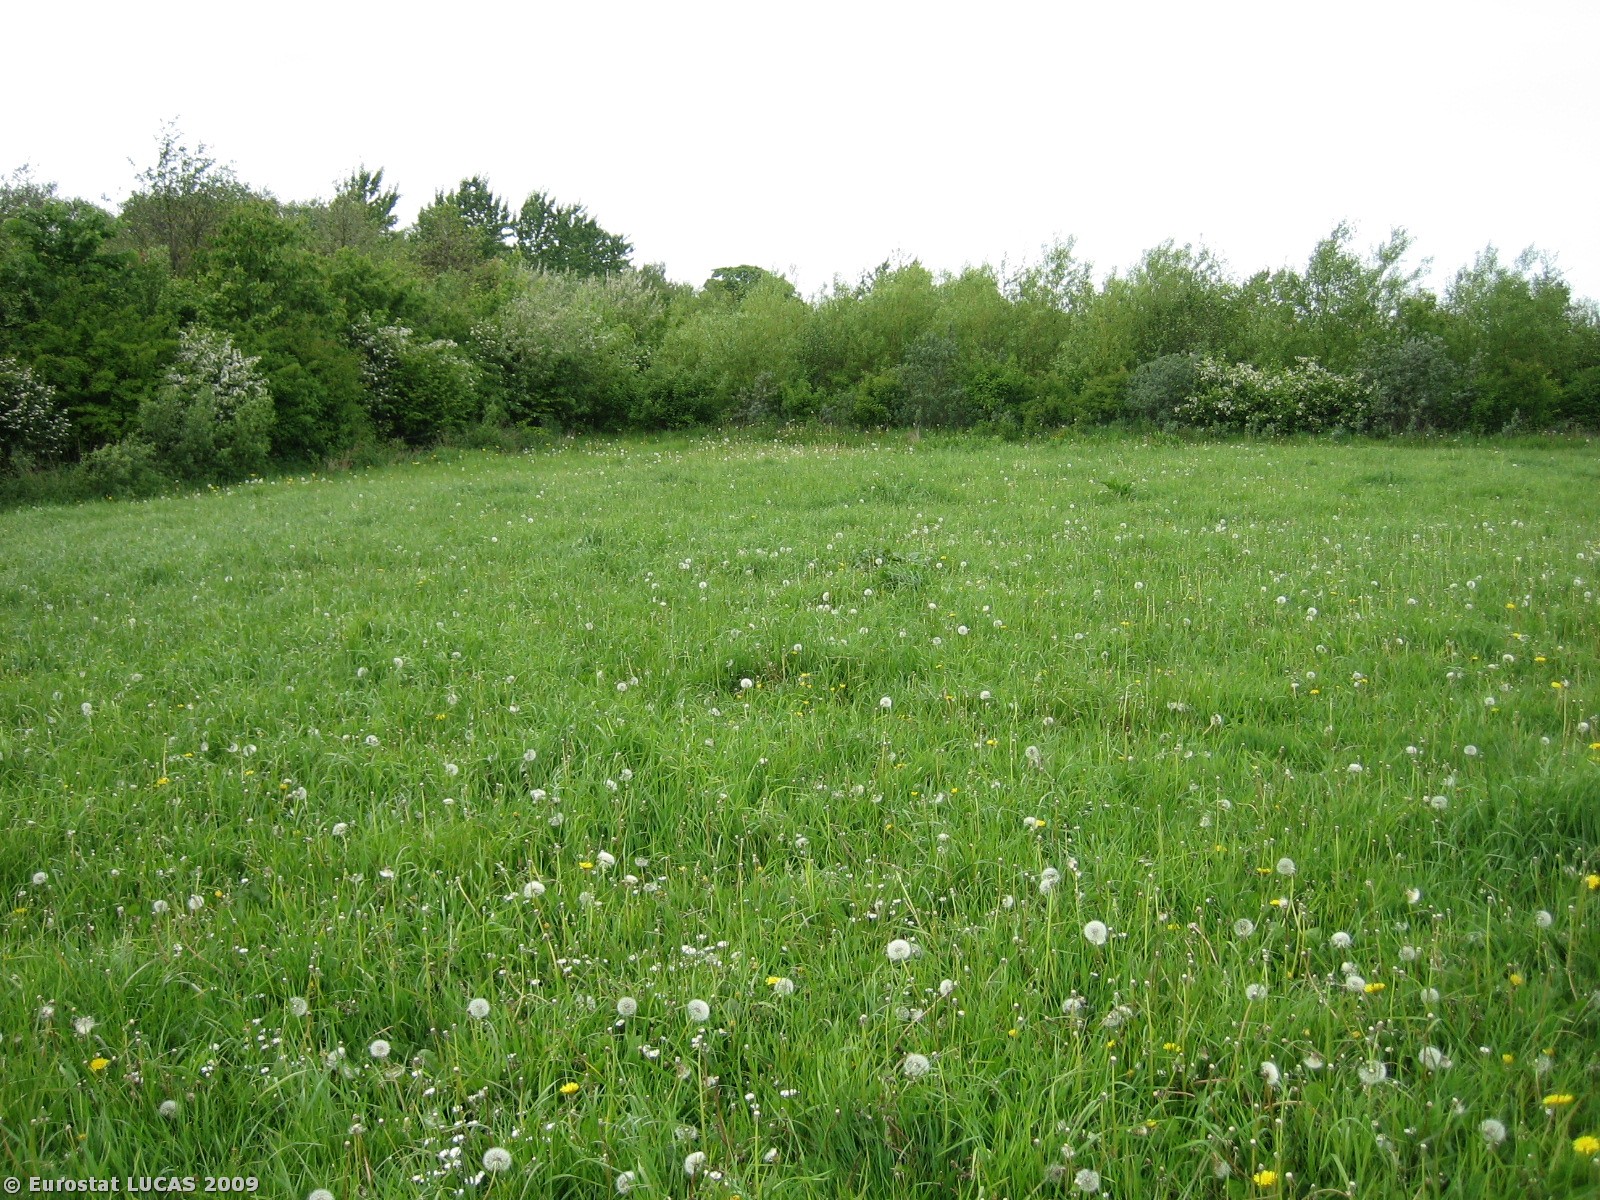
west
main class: Grassland
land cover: Grassland without tree/shrub cover
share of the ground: > 75 %
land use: Agriculture (excluding fallow land and kitchen gardens)
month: May
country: DK
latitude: 56.2186
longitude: 8.8564
